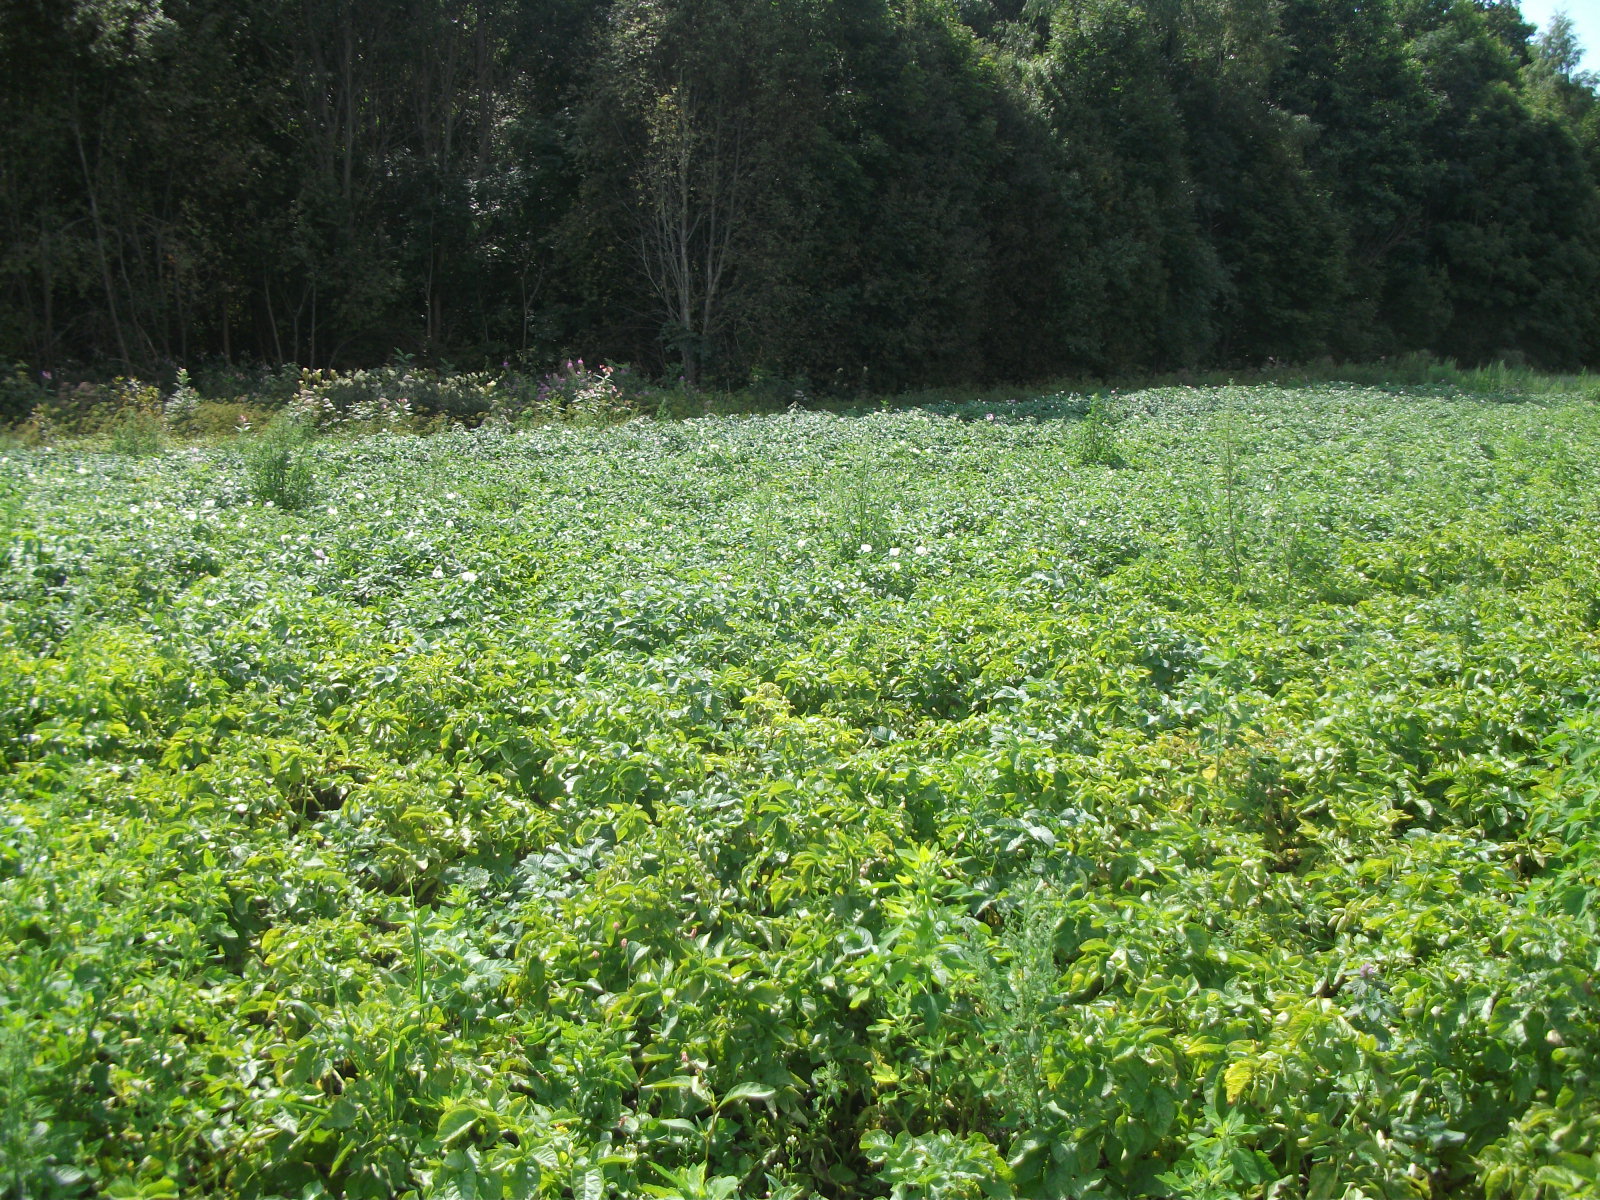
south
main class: Cropland
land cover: Potatoes
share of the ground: > 75 %
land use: Agriculture (excluding fallow land and kitchen gardens)
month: August
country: LV
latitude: 57.1319
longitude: 26.6539
